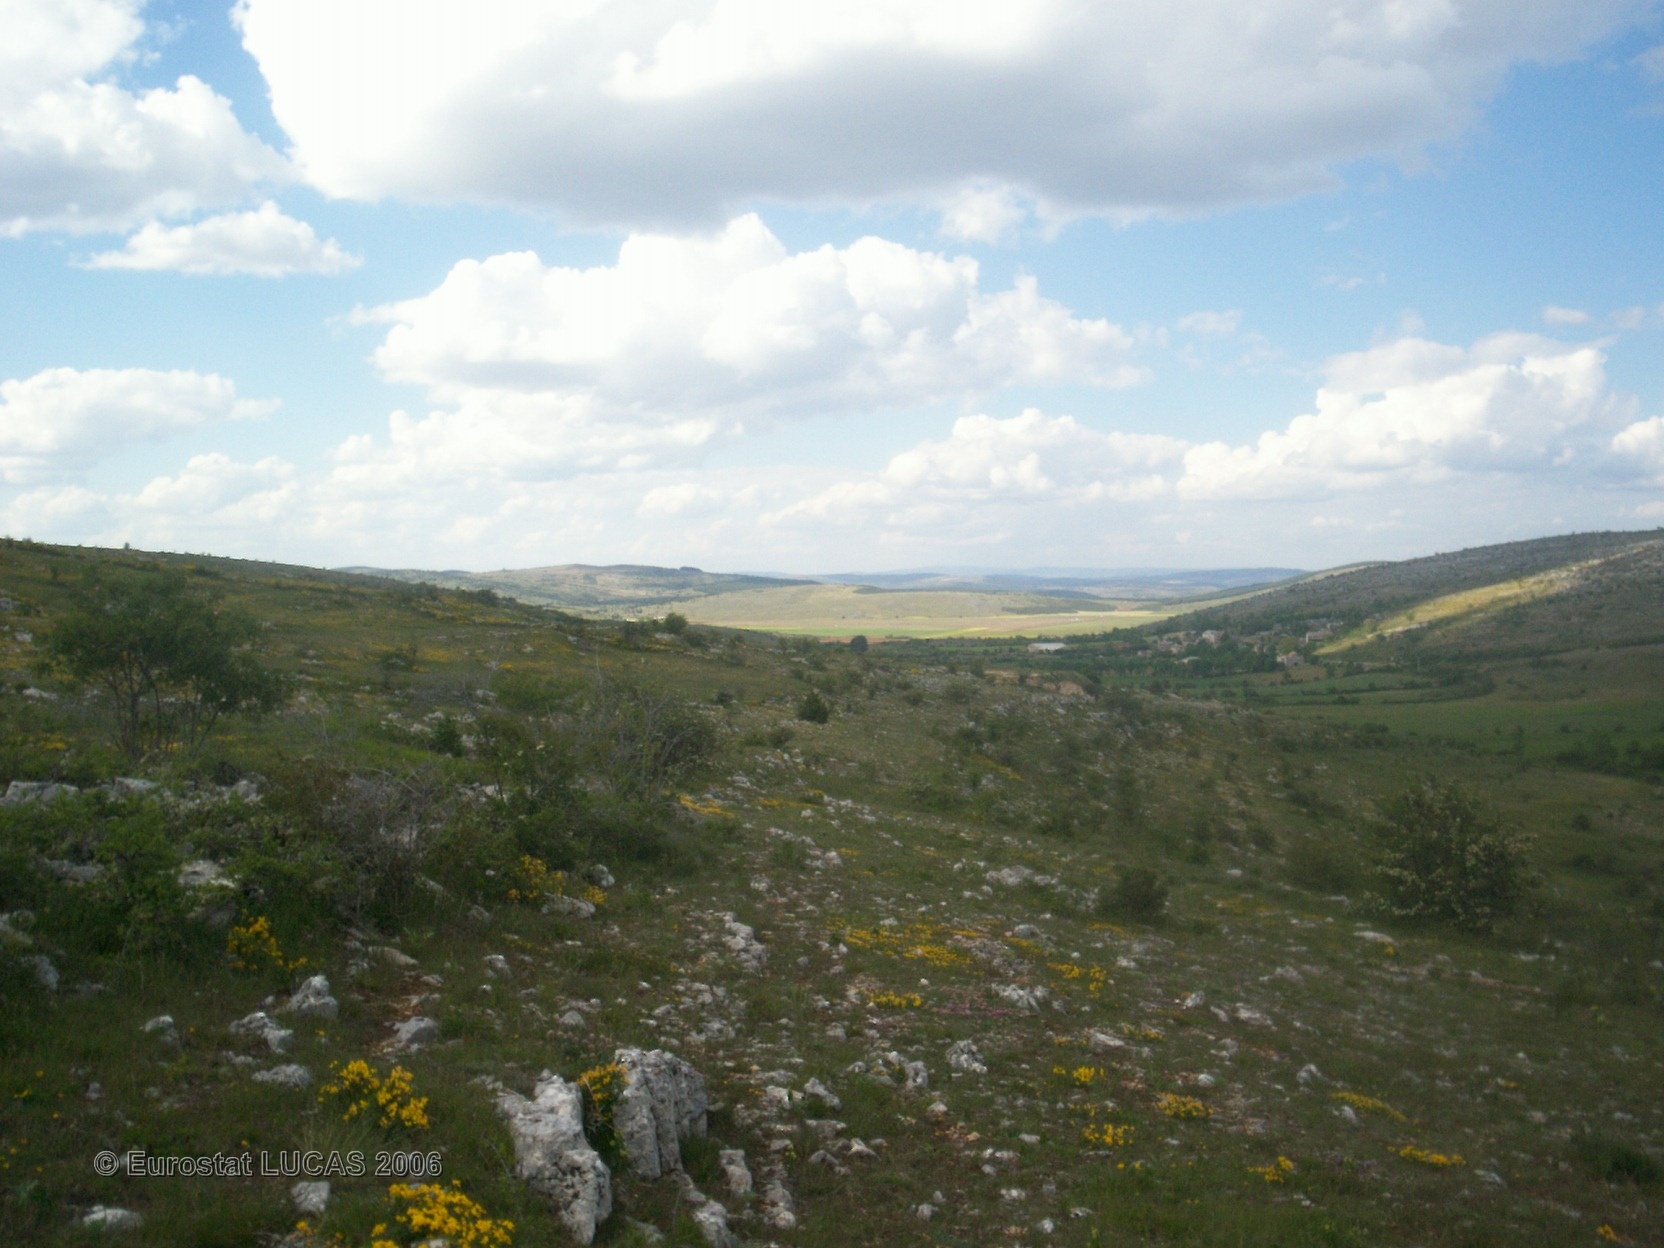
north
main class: Grassland
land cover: Grassland without tree/shrub cover
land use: Agriculture (excluding fallow land and kitchen gardens)
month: June
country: FR
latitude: 44.2525
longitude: 3.4560
